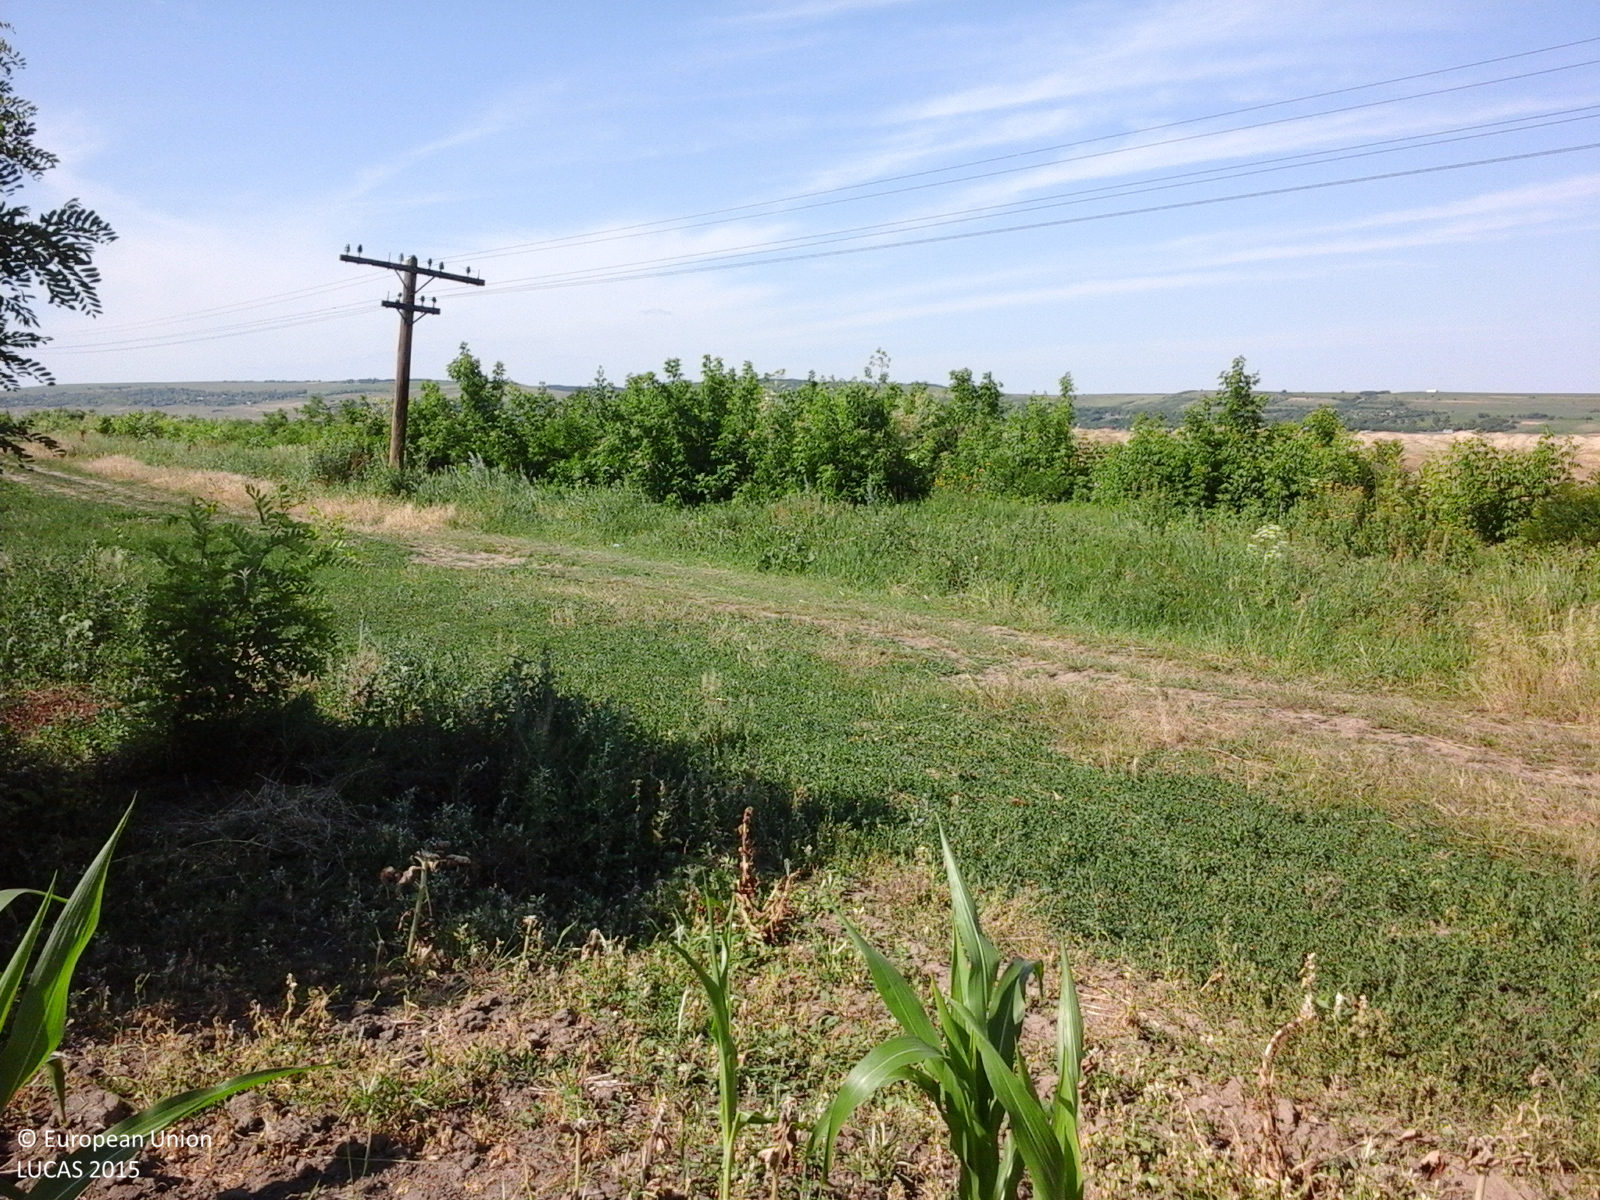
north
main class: Cropland
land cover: Maize
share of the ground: > 75 %
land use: Agriculture (excluding fallow land and kitchen gardens)
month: June
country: RO
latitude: 47.5292
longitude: 27.2588
